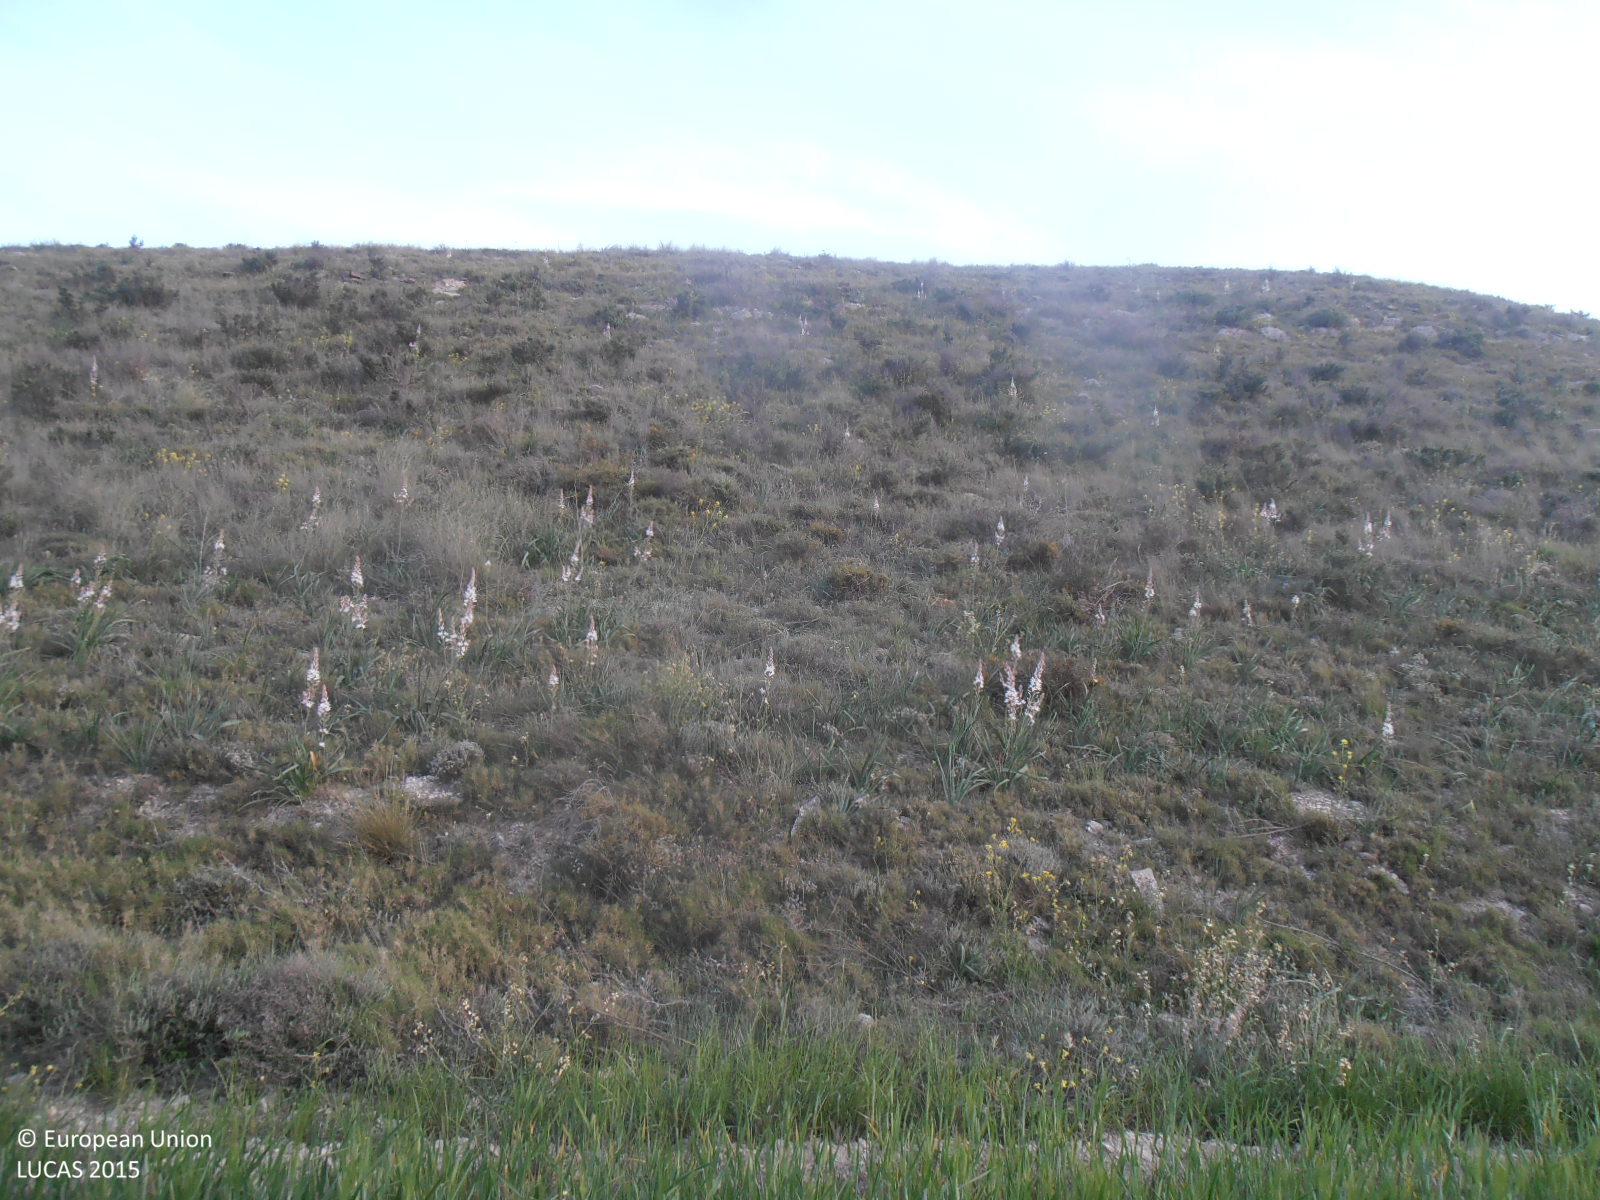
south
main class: Cropland
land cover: Durum wheat
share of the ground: > 75 %
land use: Agriculture (excluding fallow land and kitchen gardens)
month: April
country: ES
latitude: 41.3729
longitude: -0.3817
